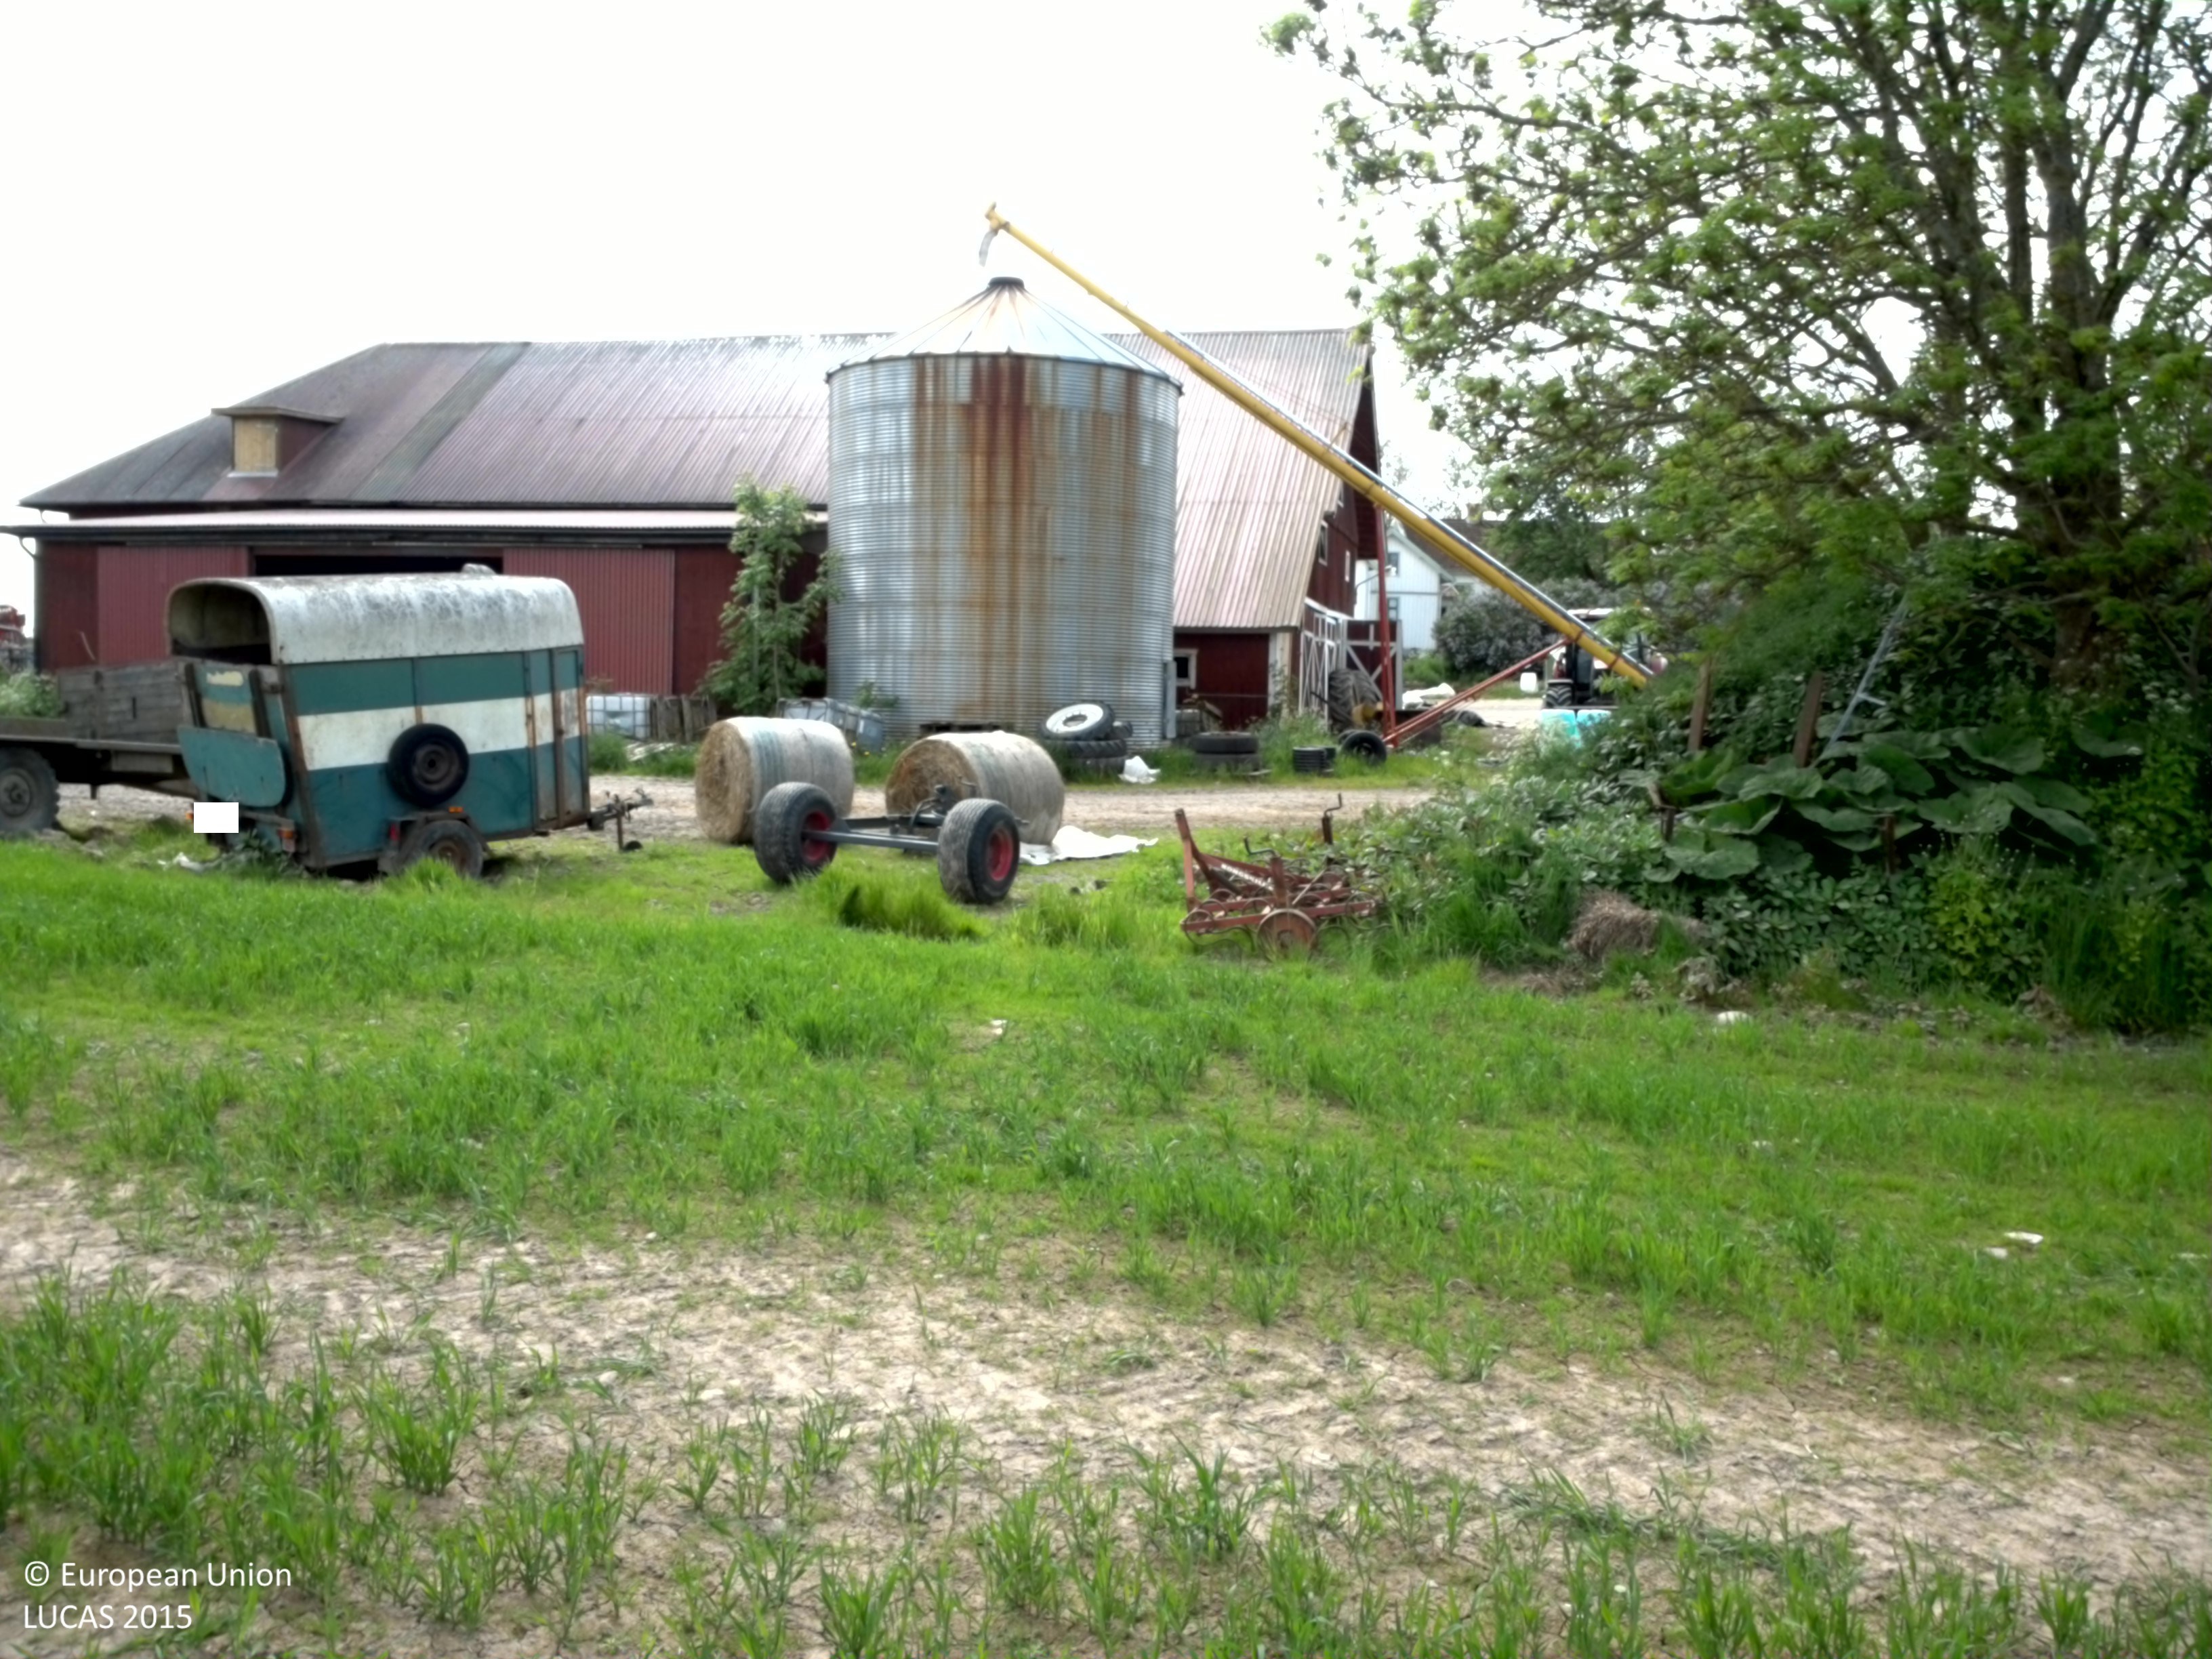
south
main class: Cropland
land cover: Oats
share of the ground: > 75 %
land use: Agriculture (excluding fallow land and kitchen gardens)
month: June
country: SE
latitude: 58.4147
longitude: 13.9137
